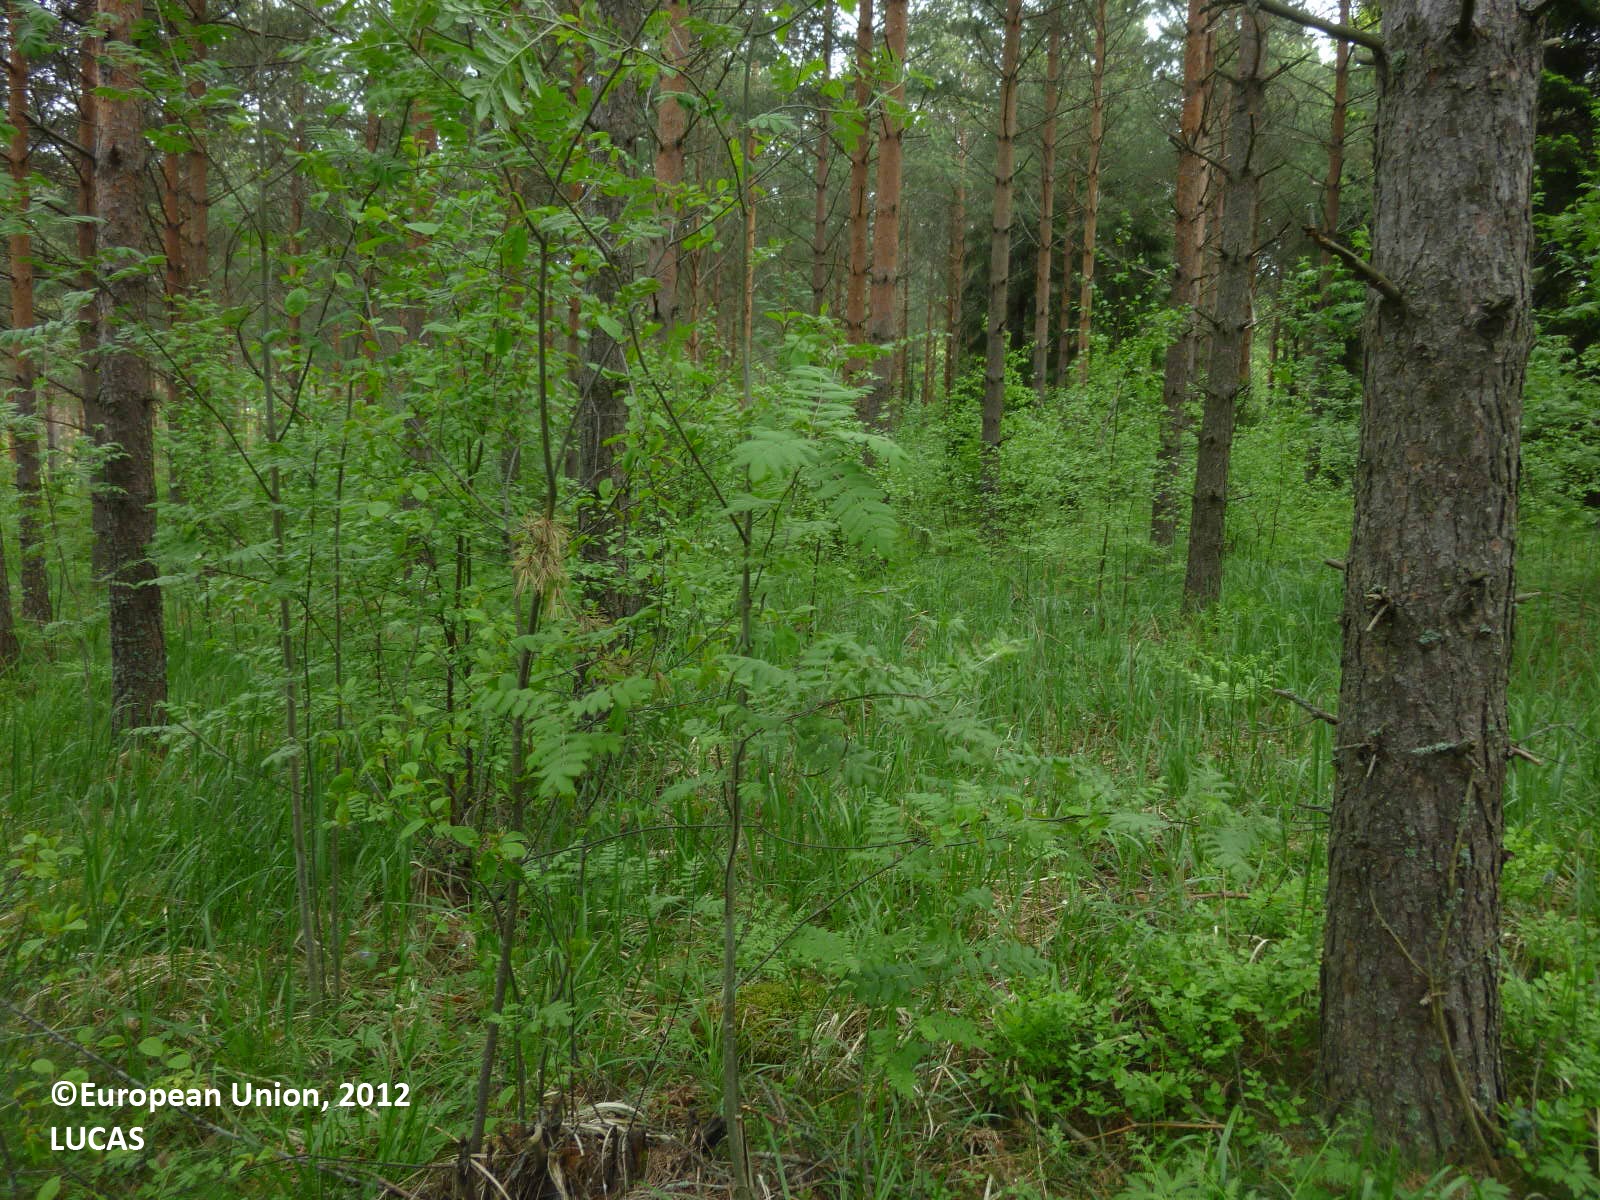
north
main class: Woodland
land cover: Pine dominated coniferous woodland
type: boreal forest
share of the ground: 50 - 75 %
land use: Forestry
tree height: > 5 m
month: June
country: FI
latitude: 60.4260
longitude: 22.6978
